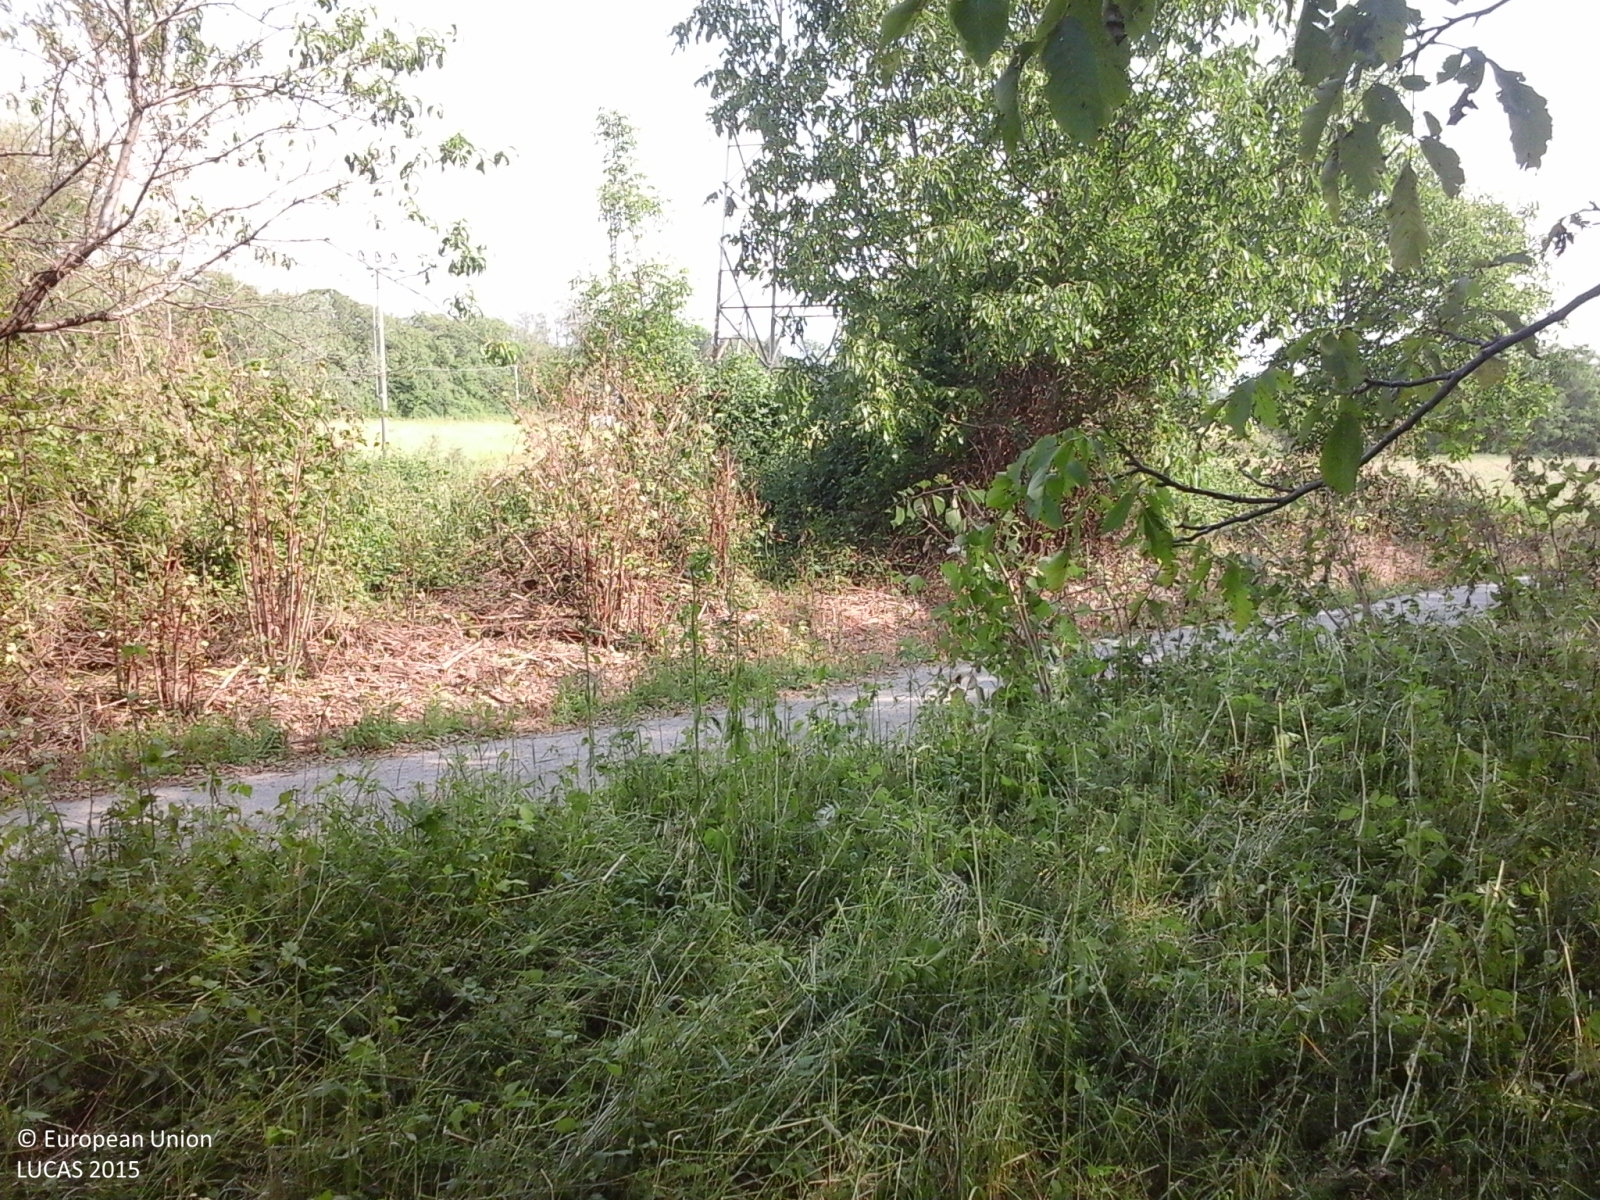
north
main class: Cropland
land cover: Nuts trees
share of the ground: > 75 %
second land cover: Grassland without tree/shrub cover
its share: > 75 %
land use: Agriculture (excluding fallow land and kitchen gardens)
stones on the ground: 10 - 25 %
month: May
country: IT
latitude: 44.8209
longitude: 7.3112
